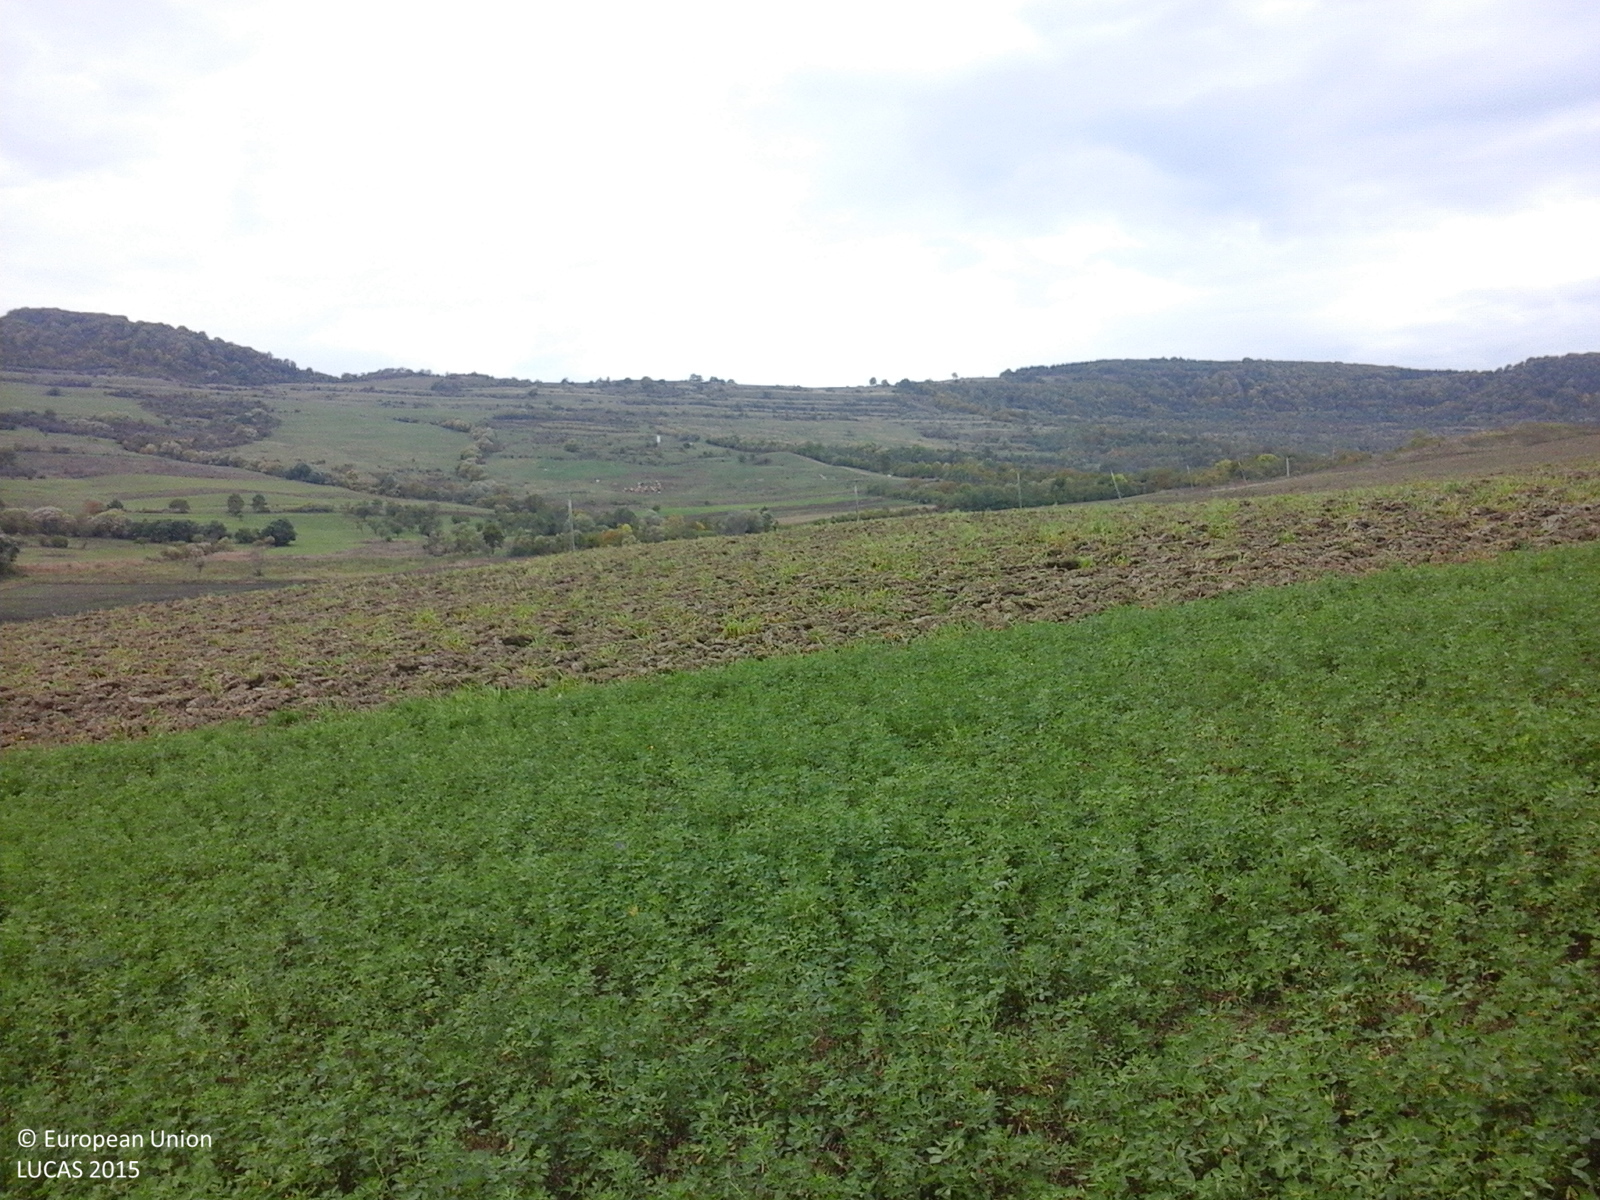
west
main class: Cropland
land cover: Lucerne
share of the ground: > 75 %
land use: Agriculture (excluding fallow land and kitchen gardens)
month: October
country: RO
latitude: 46.3544
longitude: 25.0821
